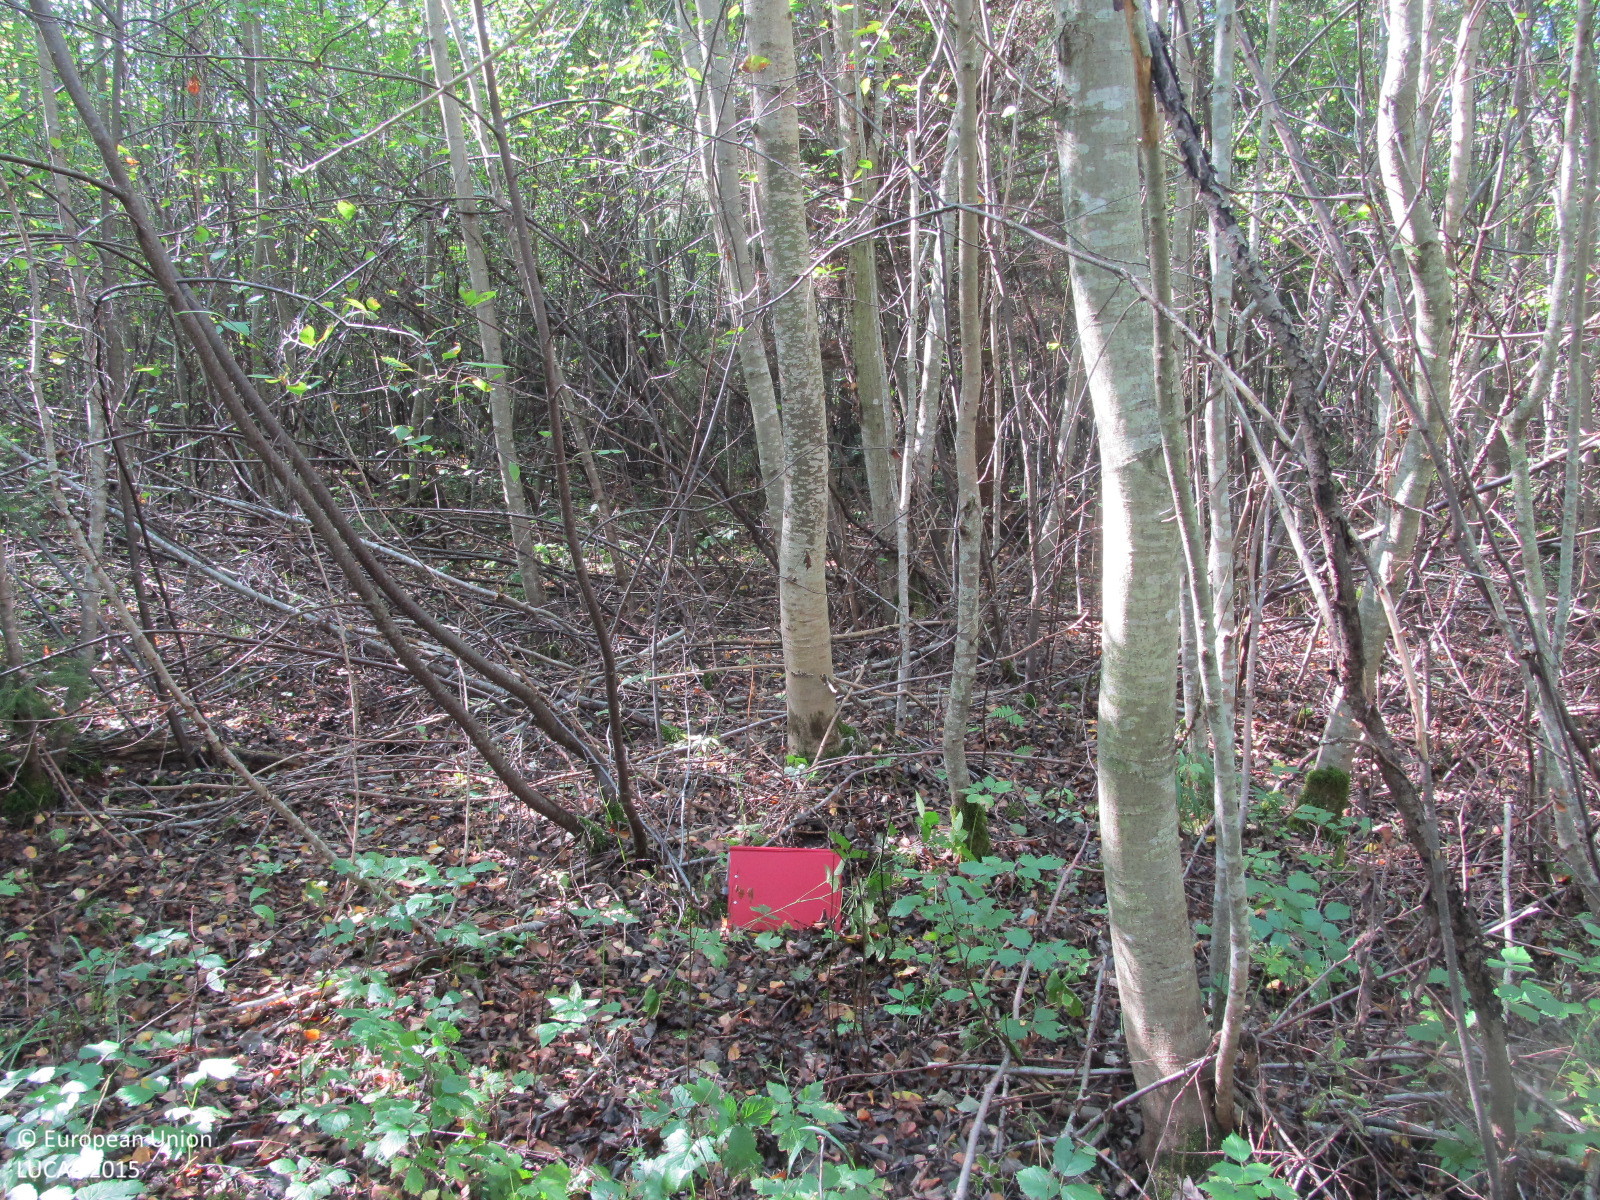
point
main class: Woodland
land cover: Broadleaved woodland
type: non-riverine alder, birch or aspen forest
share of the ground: > 75 %
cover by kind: broadleaved forest trees 85 %, shrubs 5 %, herbaceous plants 5 %, unconsolidated bare surface 5 %
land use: Forestry
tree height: > 5 m
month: September
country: LT
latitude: 56.0868
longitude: 23.3648
